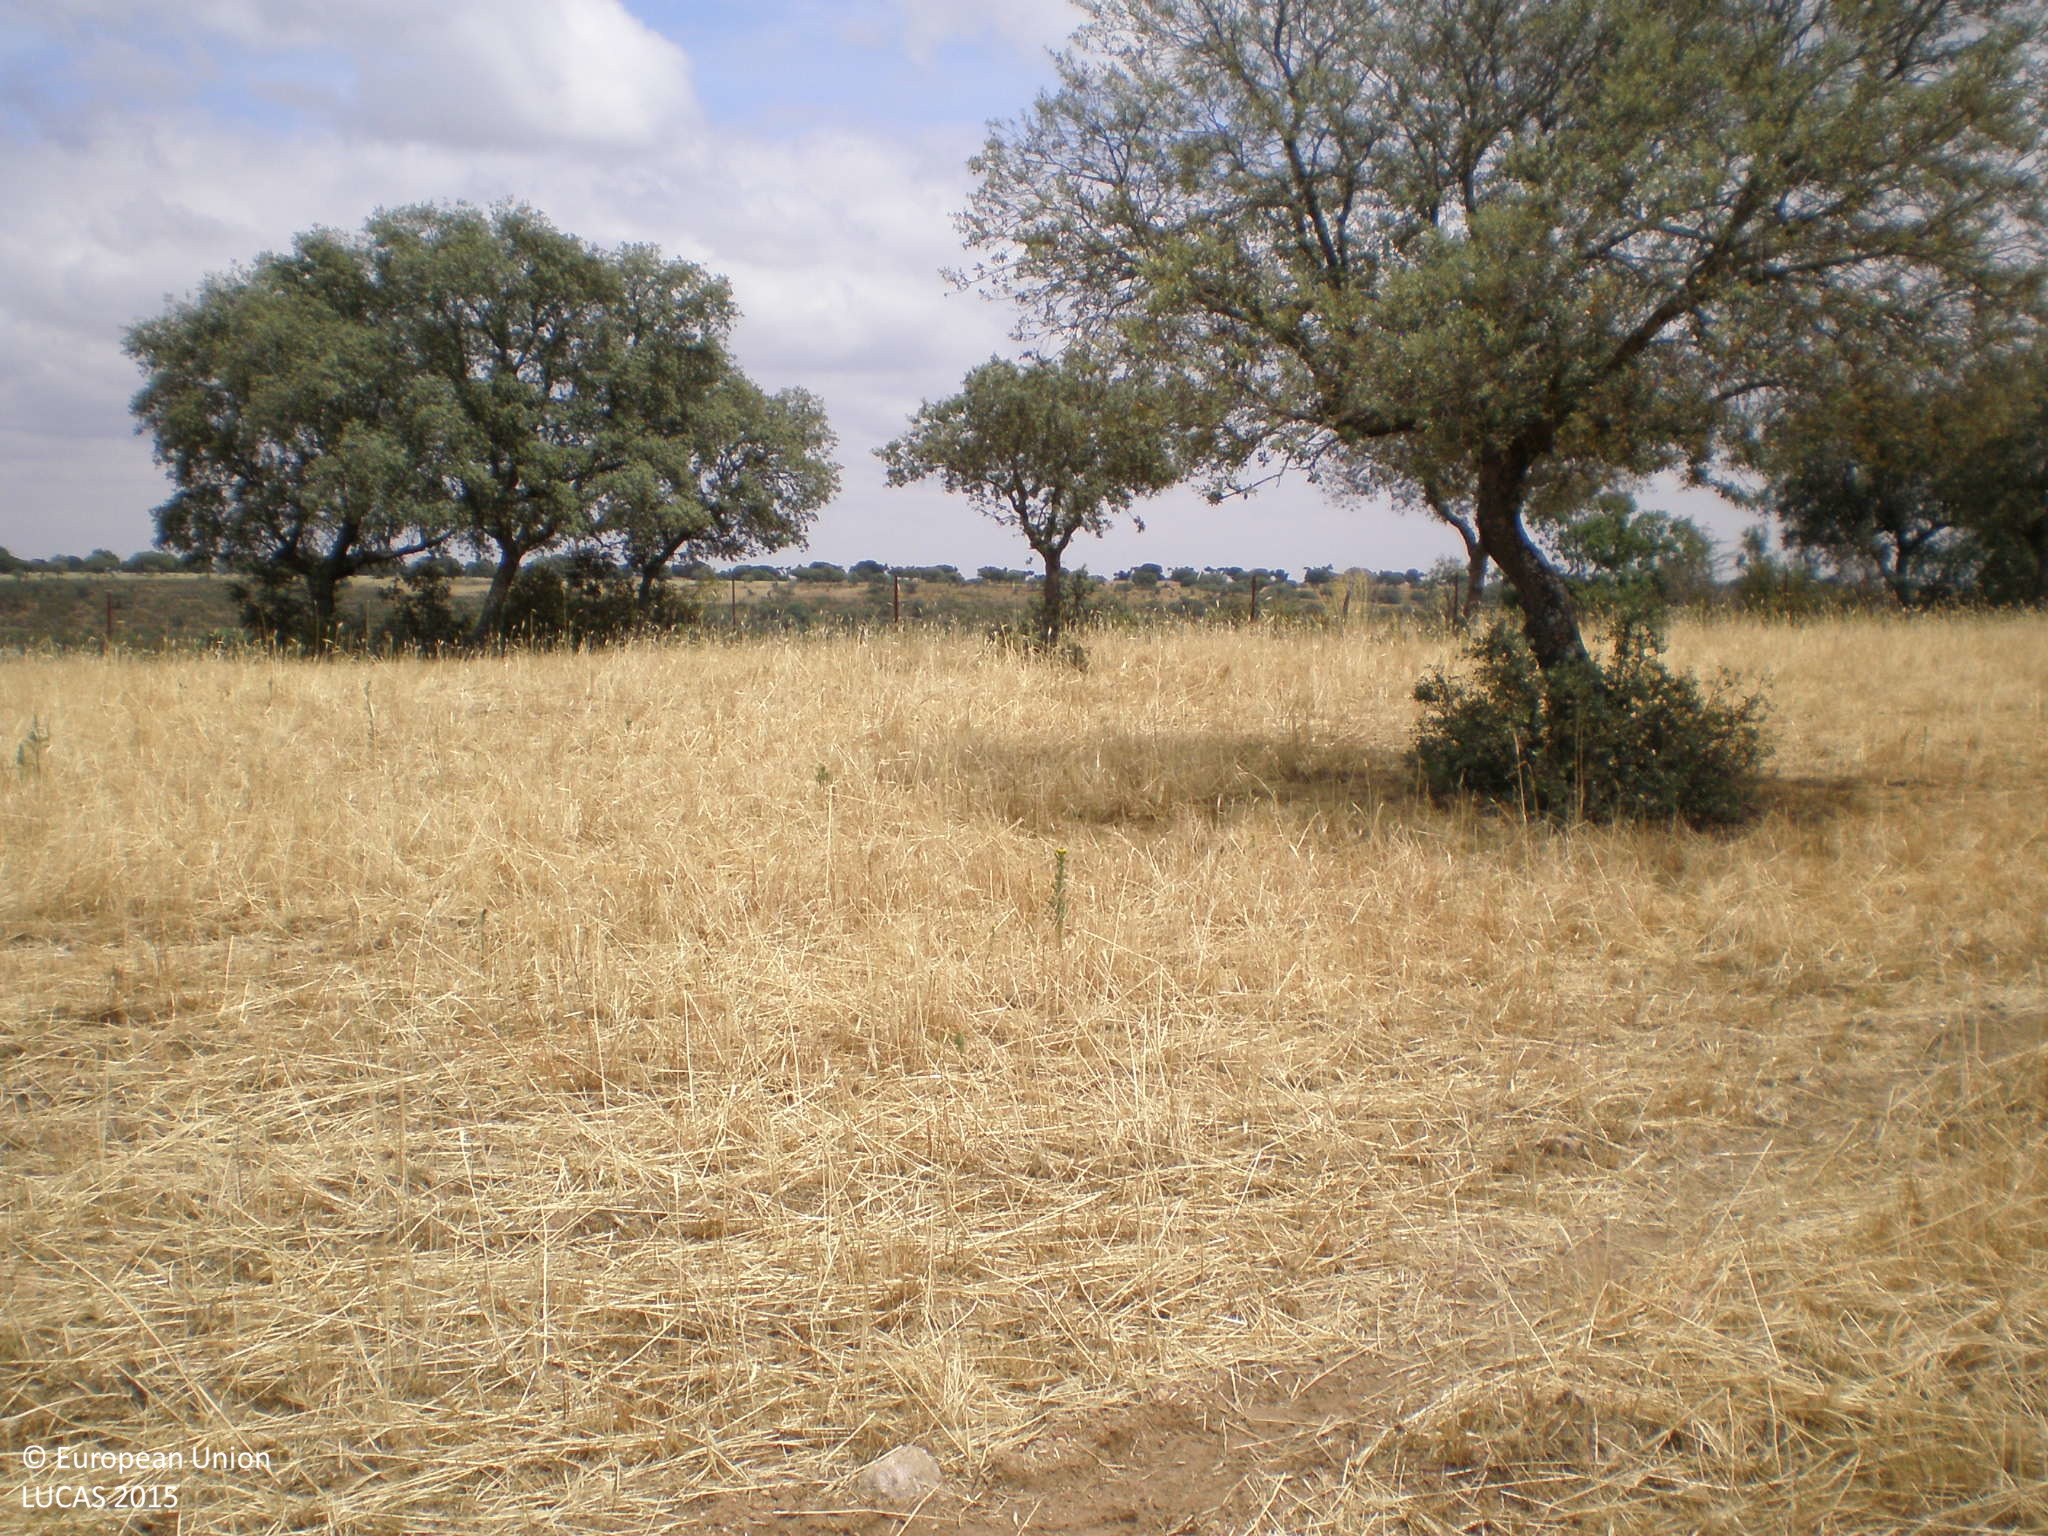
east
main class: Woodland
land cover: Broadleaved woodland
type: broadleaved evergreen forest
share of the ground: 25 - 50 %
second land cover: Rye
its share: 50 - 75 %
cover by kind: herbaceous plants 70 %, broadleaved forest trees 30 %
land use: Forestry
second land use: Agriculture (excluding fallow land and kitchen gardens)
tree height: < 5 m
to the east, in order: Broadleaved woodland; Rye; Fences; Grass margins; Common wheat
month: June
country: ES
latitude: 41.1376
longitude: -5.7474
